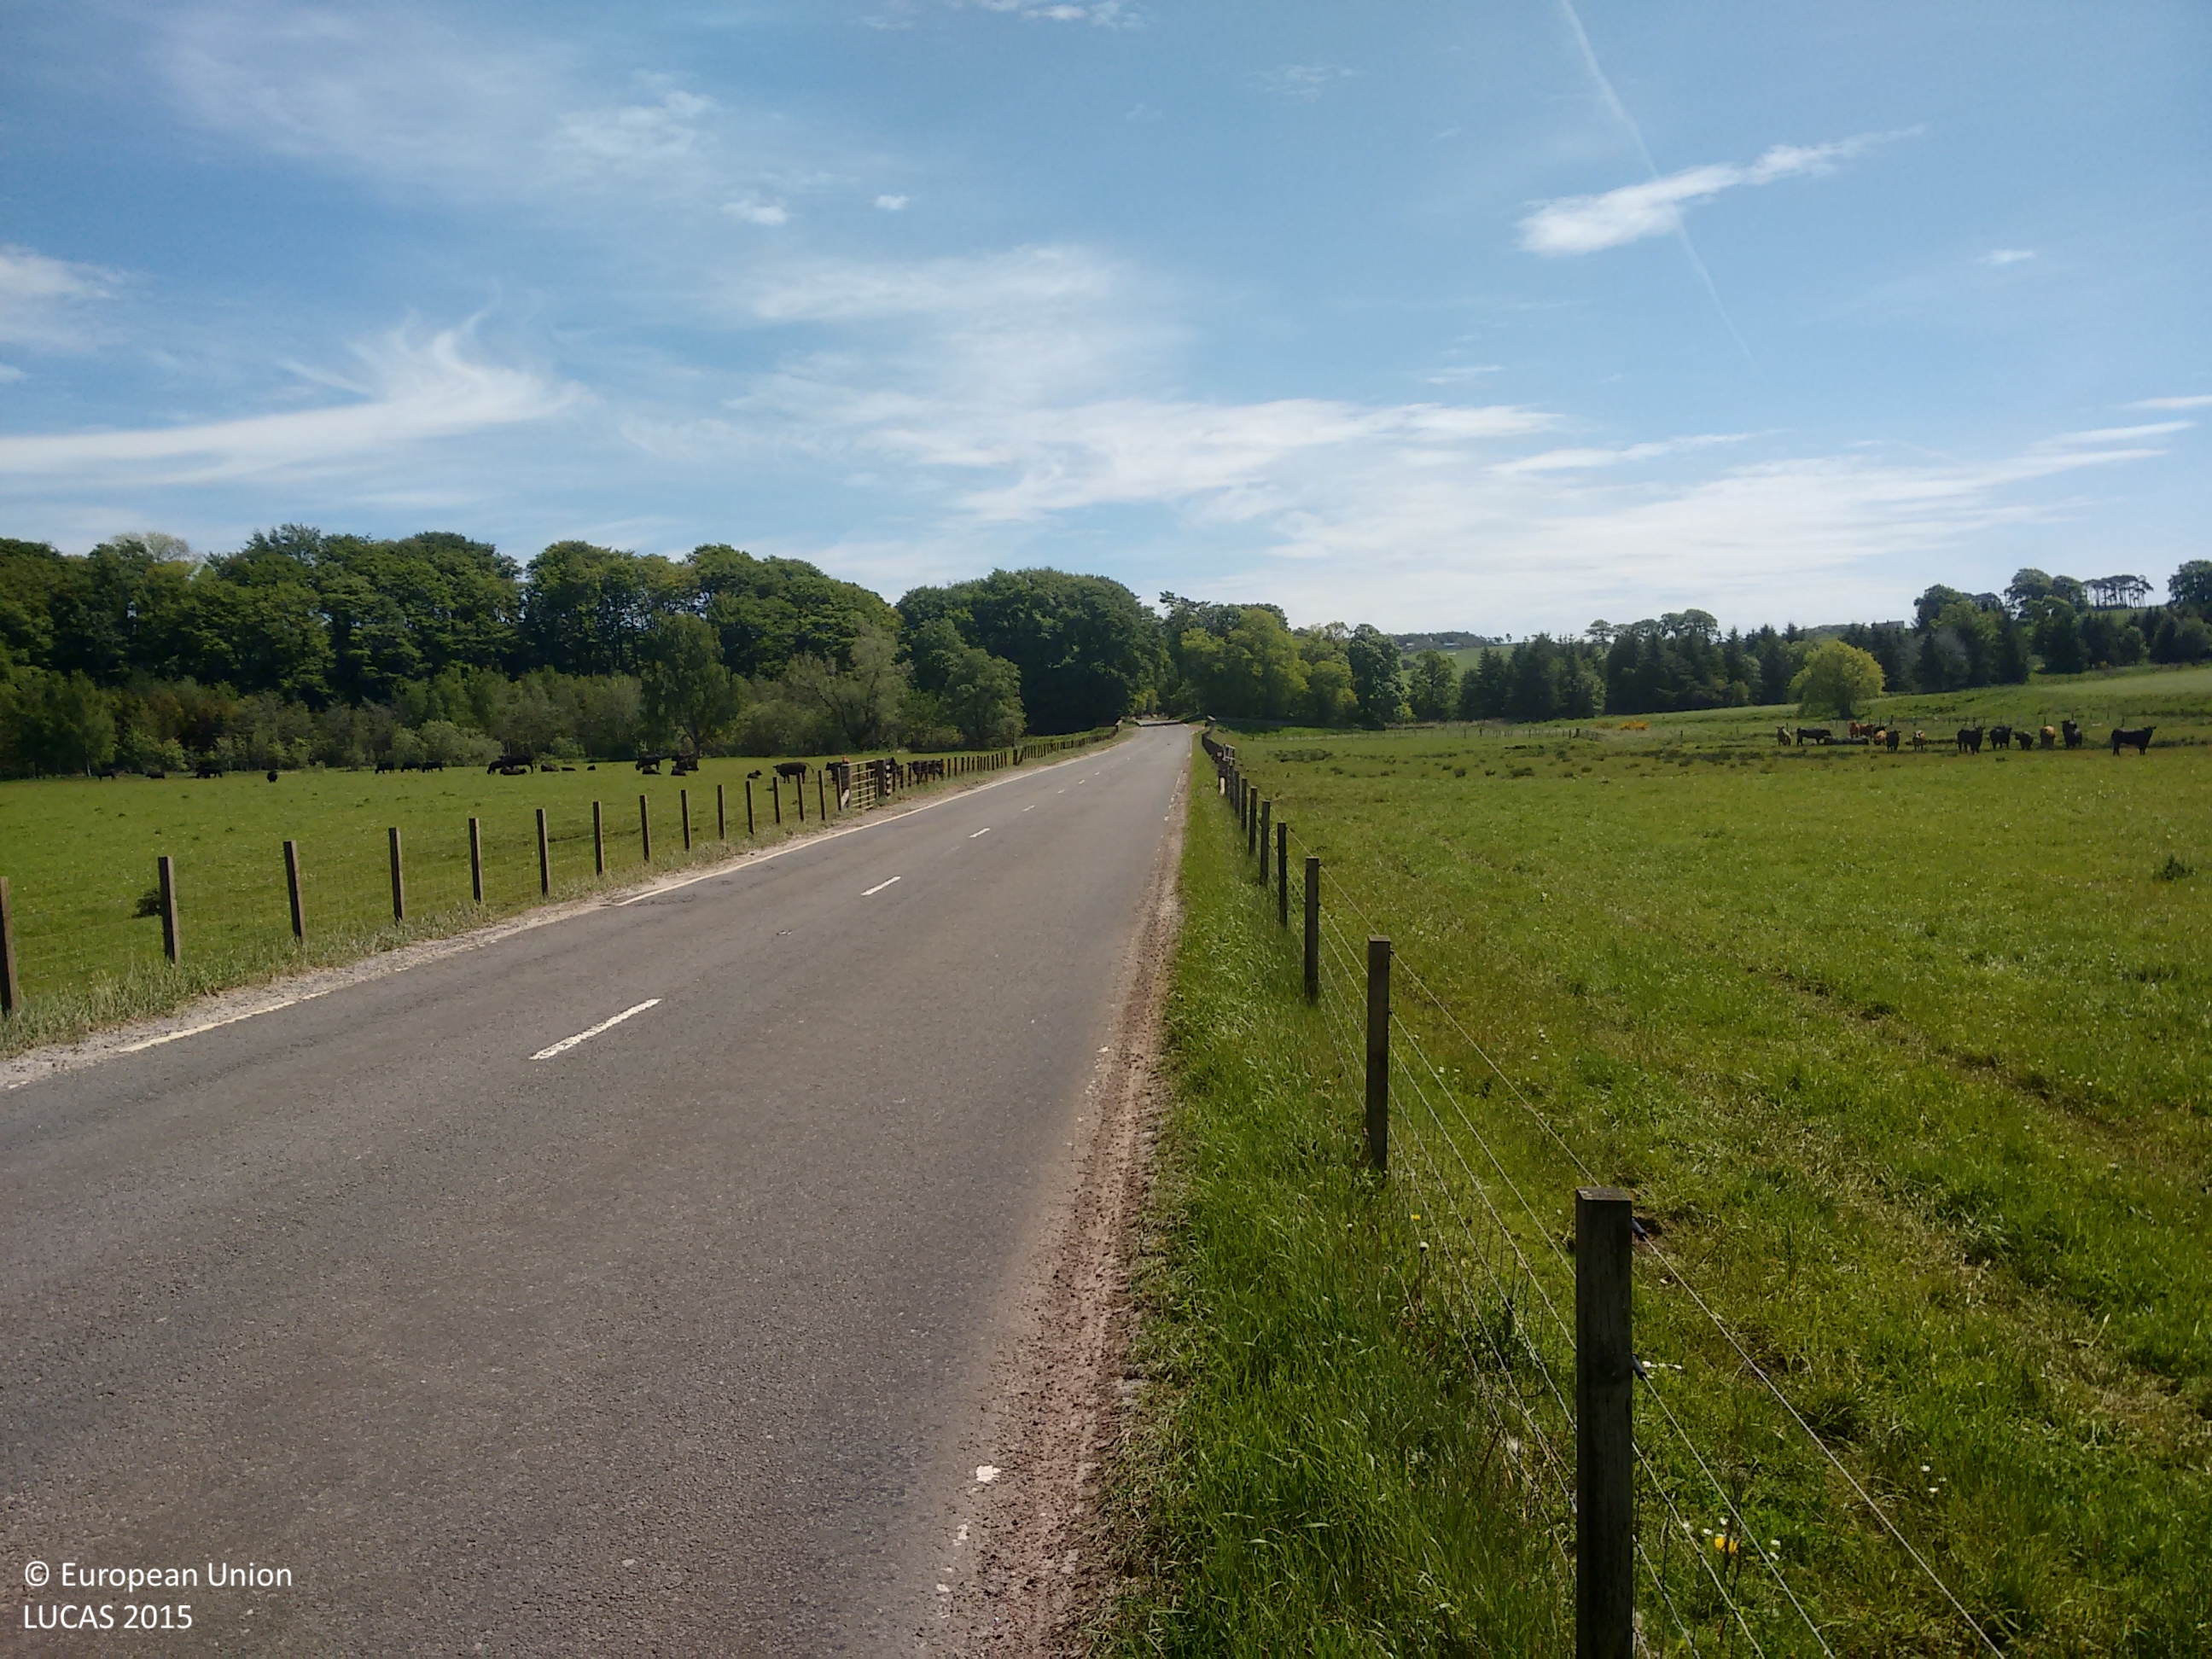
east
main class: Grassland
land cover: Grassland without tree/shrub cover
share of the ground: > 75 %
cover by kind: herbaceous plants 75 %, lichens and mosses 25 %
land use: Agriculture (excluding fallow land and kitchen gardens)
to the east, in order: Grassland without tree/shrub cover; Fences; Grassland without tree/shrub cover; Inland fresh running water; Grassland without tree/shrub cover; Fences; Spontaneously vegetated surfaces; Inland fresh running water; Spontaneously vegetated surfaces
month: June
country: GB
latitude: 55.6836
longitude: -3.5508
